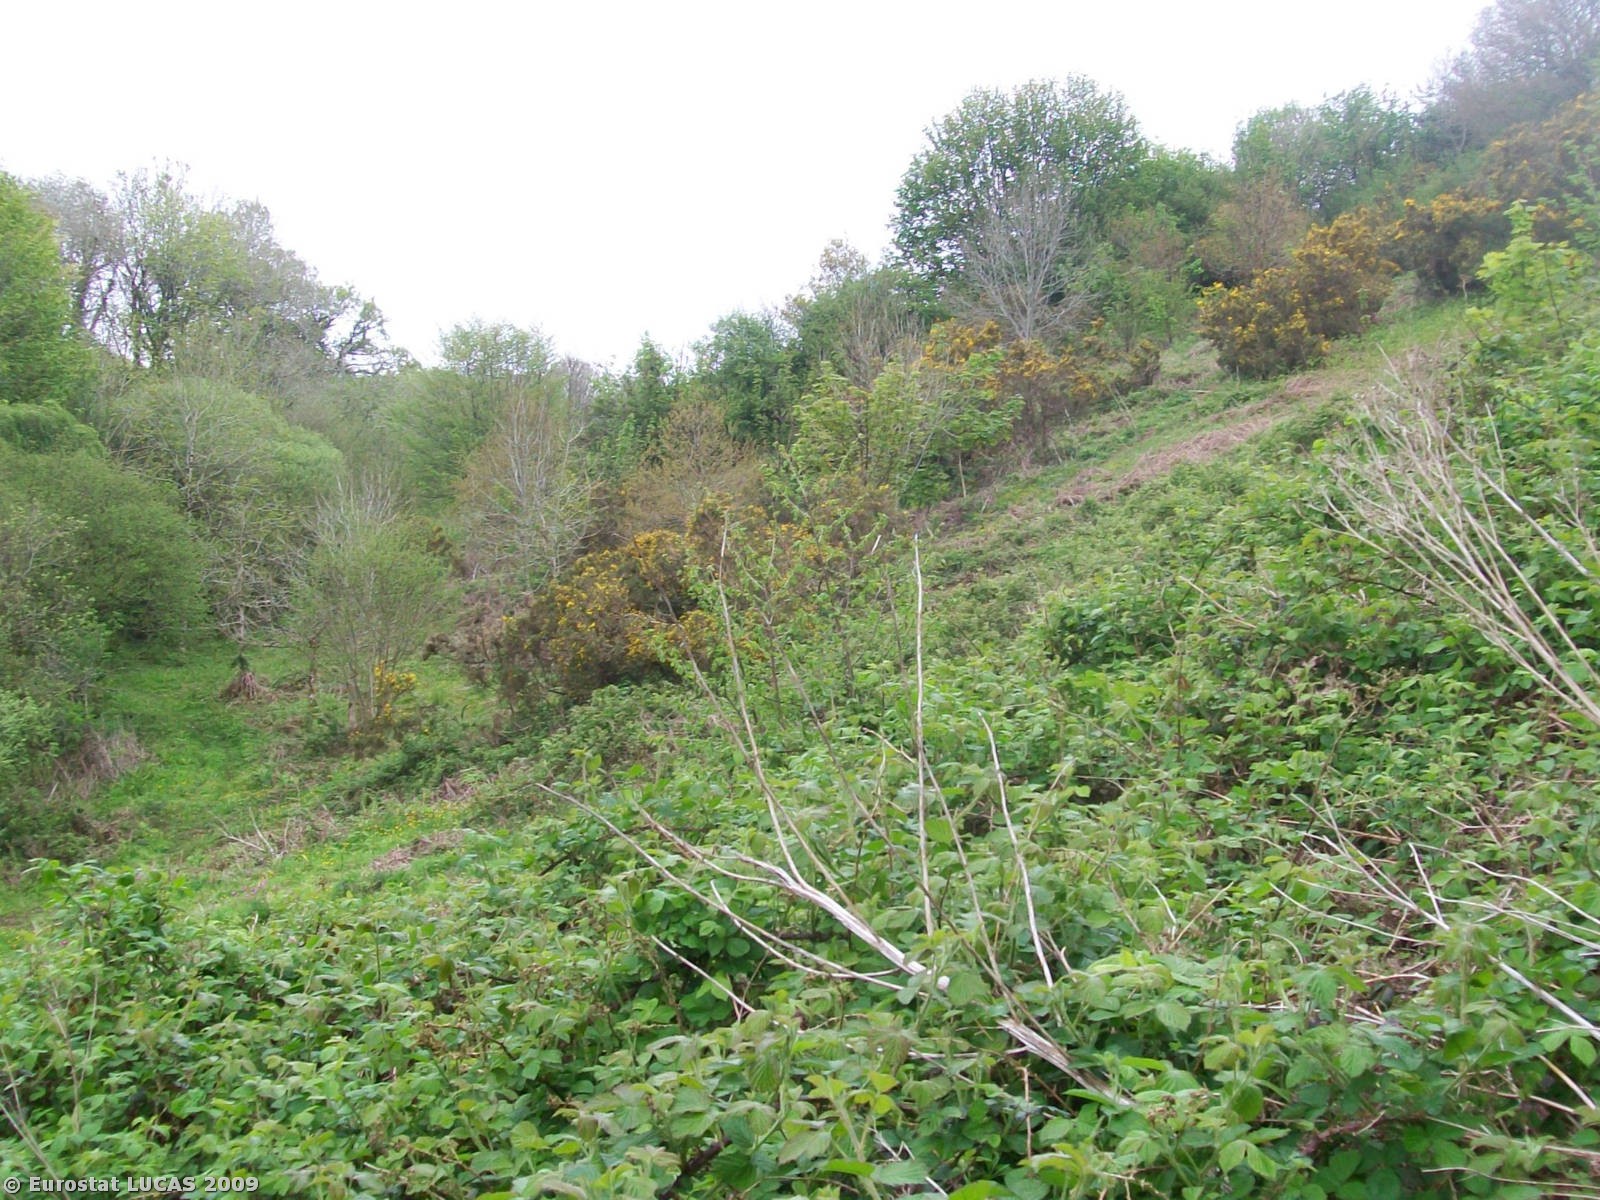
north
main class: Shrubland
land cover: Shrubland with sparse tree cover
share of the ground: > 75 %
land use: Agriculture (excluding fallow land and kitchen gardens)
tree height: > 5 m
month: May
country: GB
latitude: 50.5046
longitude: -4.2695
